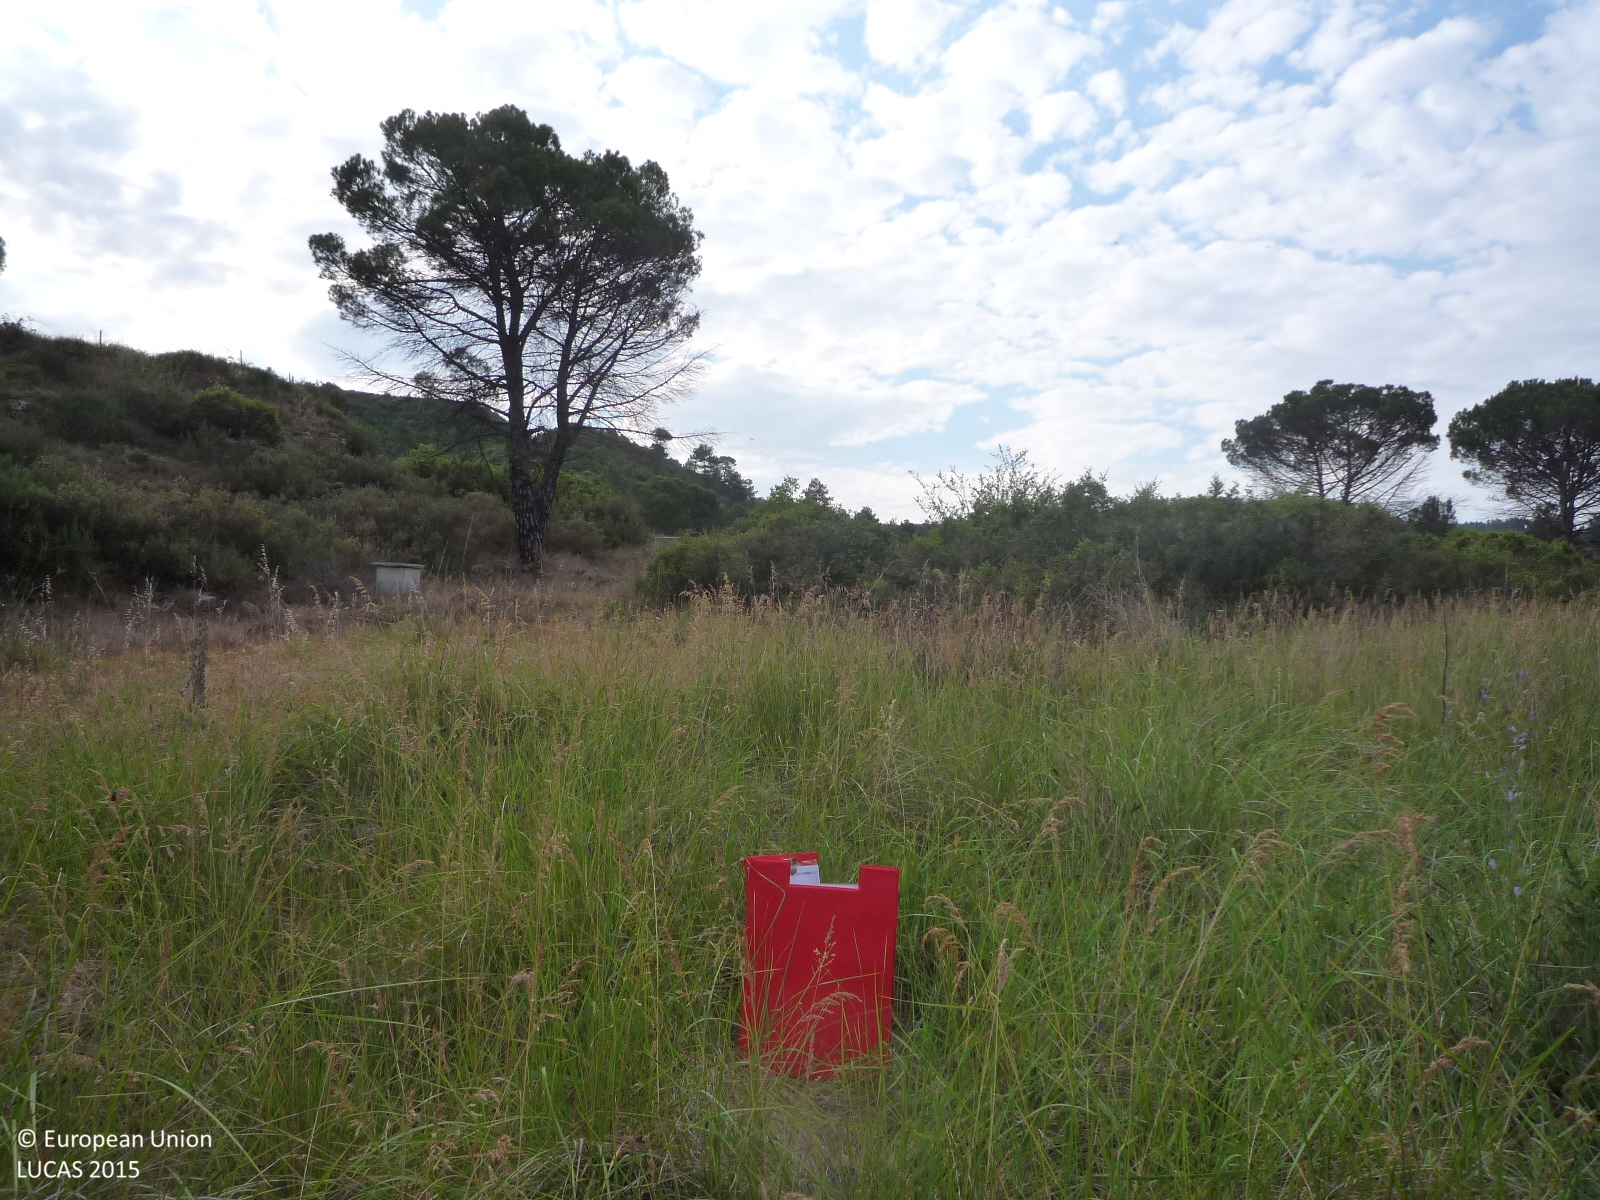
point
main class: Grassland
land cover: Grassland with sparse tree/shrub cover
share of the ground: > 75 %
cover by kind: herbaceous plants 95 %, coniferous forest trees 5 %
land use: Semi-natural and natural areas not in use
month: June
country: ES
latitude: 41.7400
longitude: 2.0196
